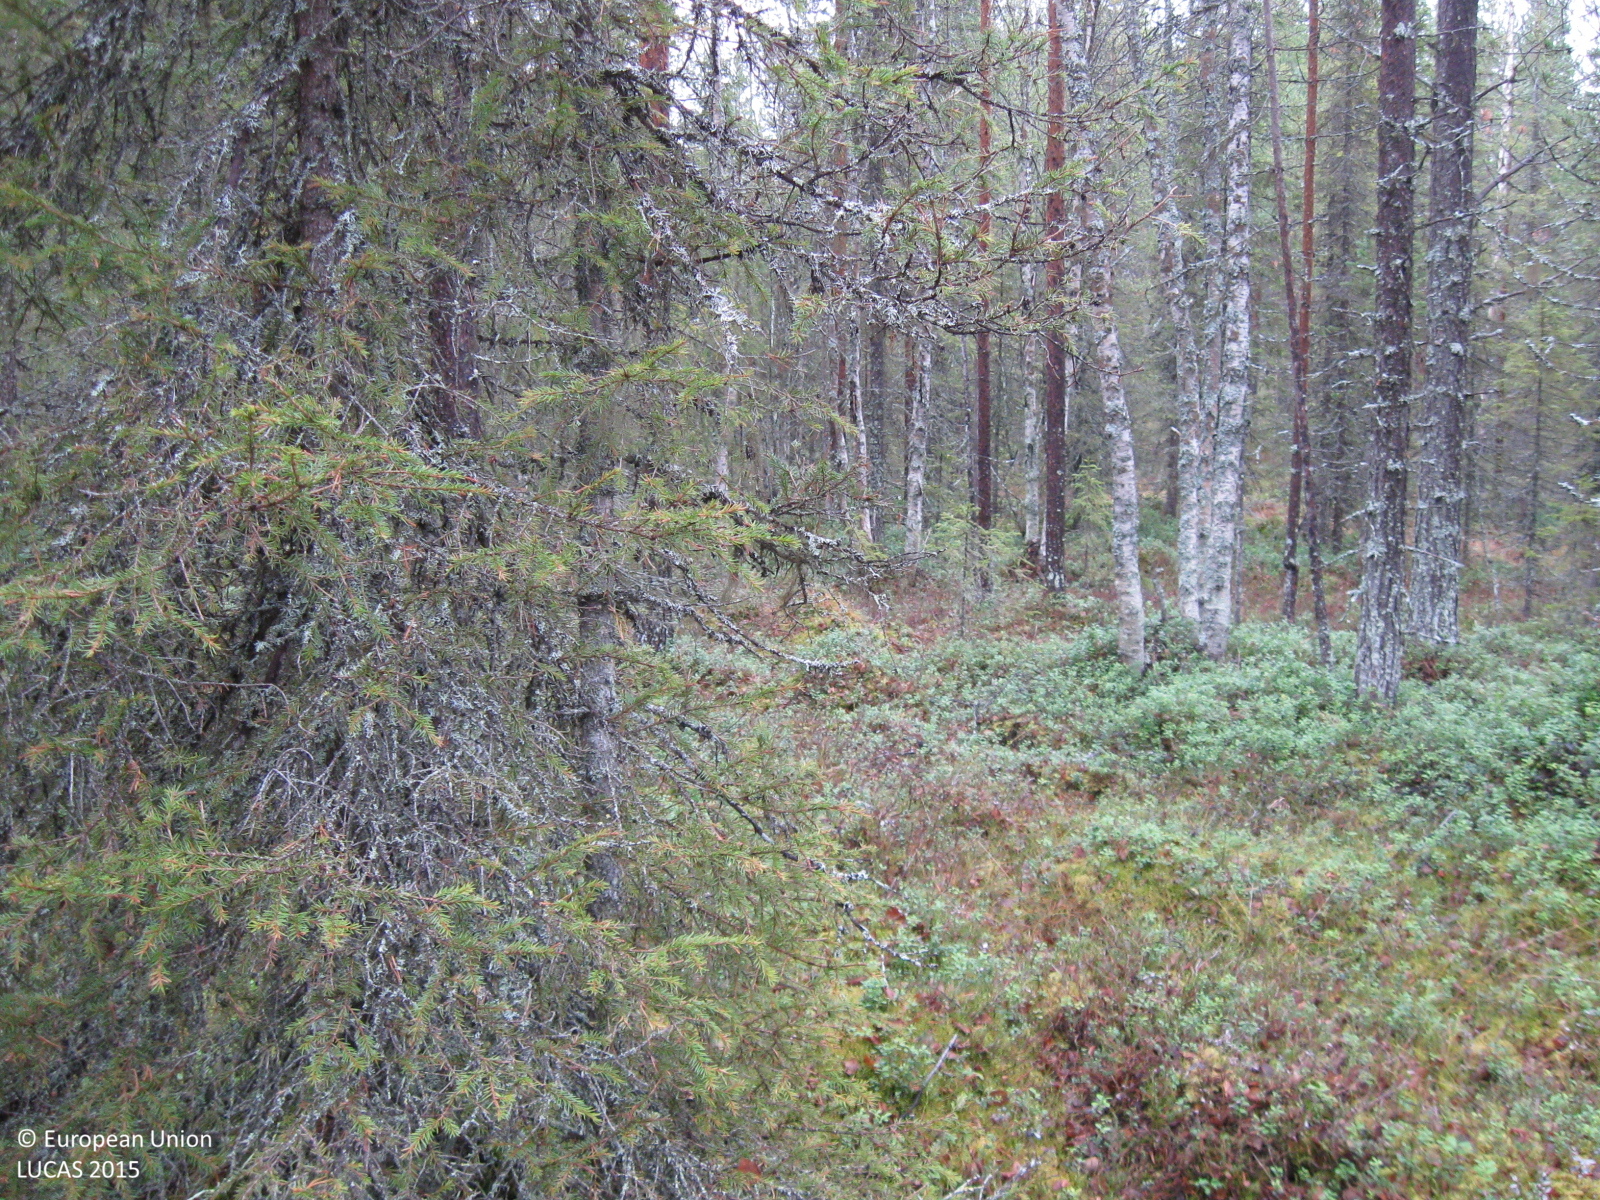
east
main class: Woodland
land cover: Other coniferous woodland
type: boreal forest
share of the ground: > 75 %
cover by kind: coniferous forest trees 70 %, broadleaved forest trees 10 %, shrubs 10 %, herbaceous plants 5 %, lichens and mosses 5 %
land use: Forestry
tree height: > 5 m
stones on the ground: 10 - 25 %
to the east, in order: Other coniferous woodland; Pine dominated coniferous woodland; Spruce dominated mixed woodland; Paved roads, cycling and walking lanes; Pine dominated mixed woodland; Spruce dominated mixed woodland
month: October
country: SE
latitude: 66.6926
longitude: 21.7167
